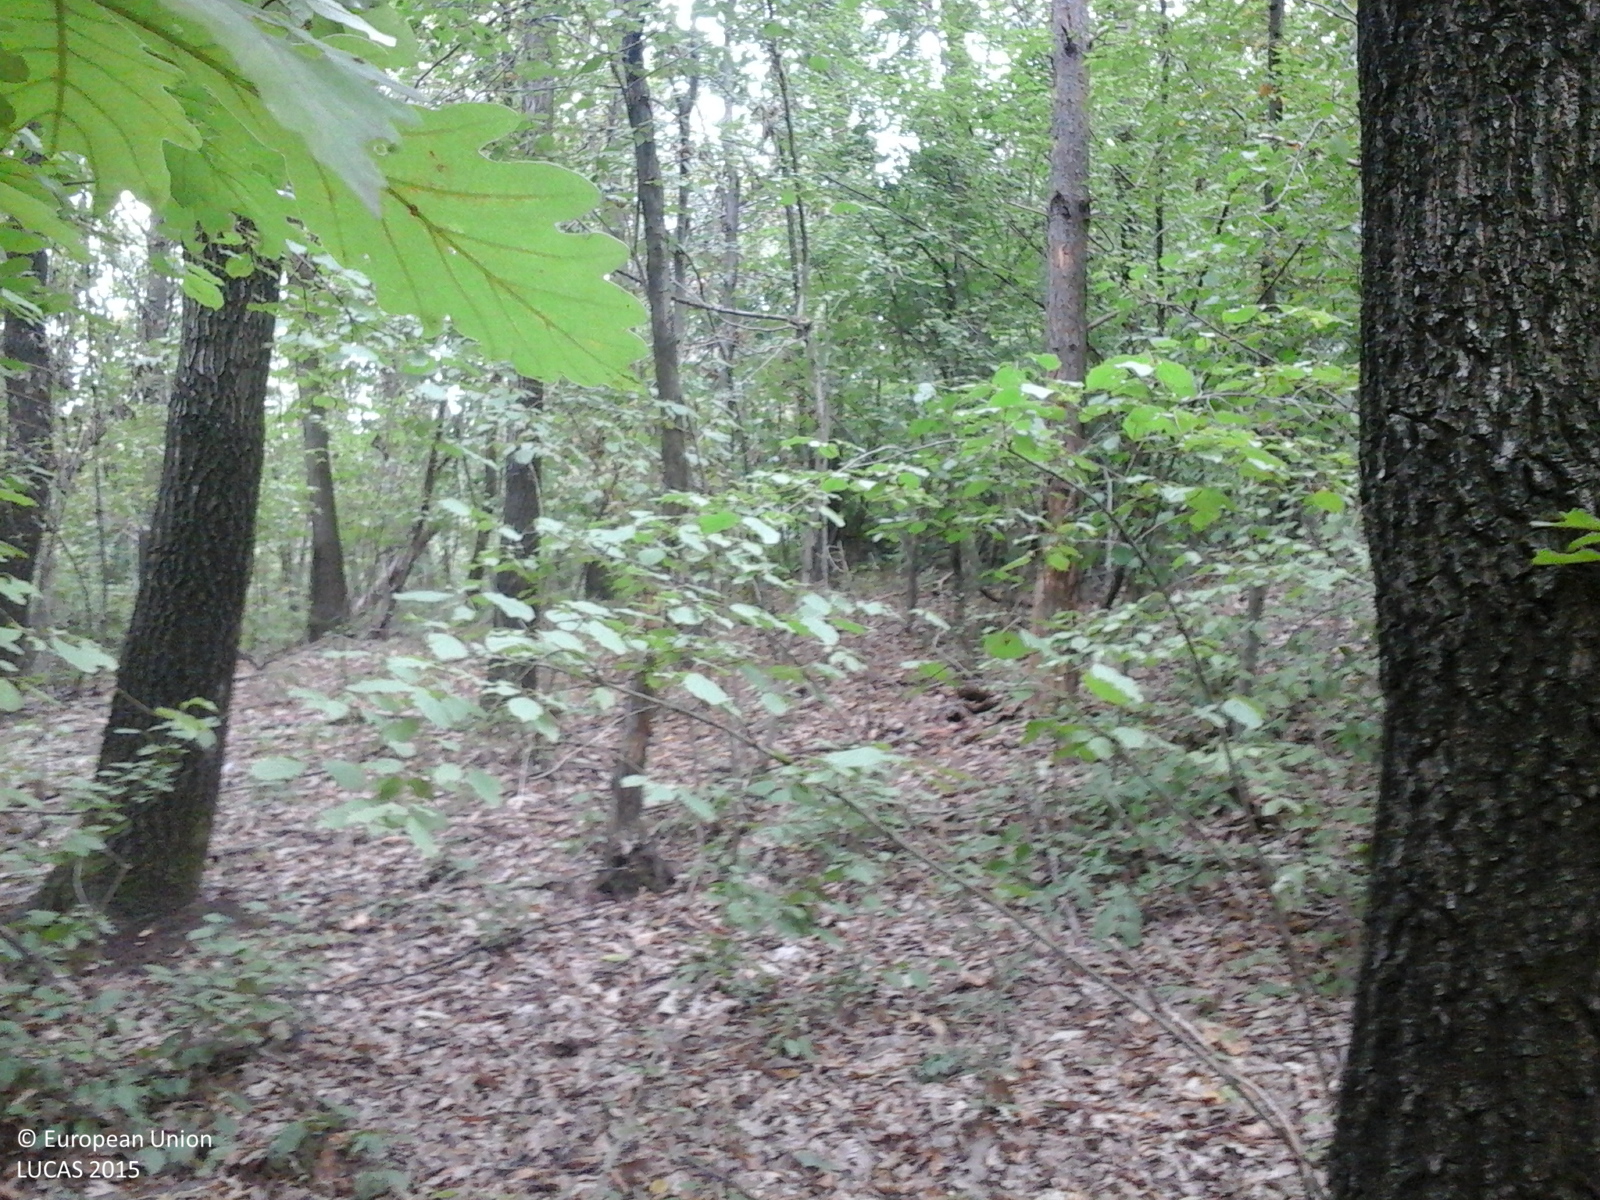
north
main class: Woodland
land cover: Broadleaved woodland
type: acidophilous oak and oak-birch forest
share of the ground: > 75 %
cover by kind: broadleaved forest trees 100 %
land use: Forestry
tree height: > 5 m
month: September
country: RO
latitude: 47.2336
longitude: 23.1292
